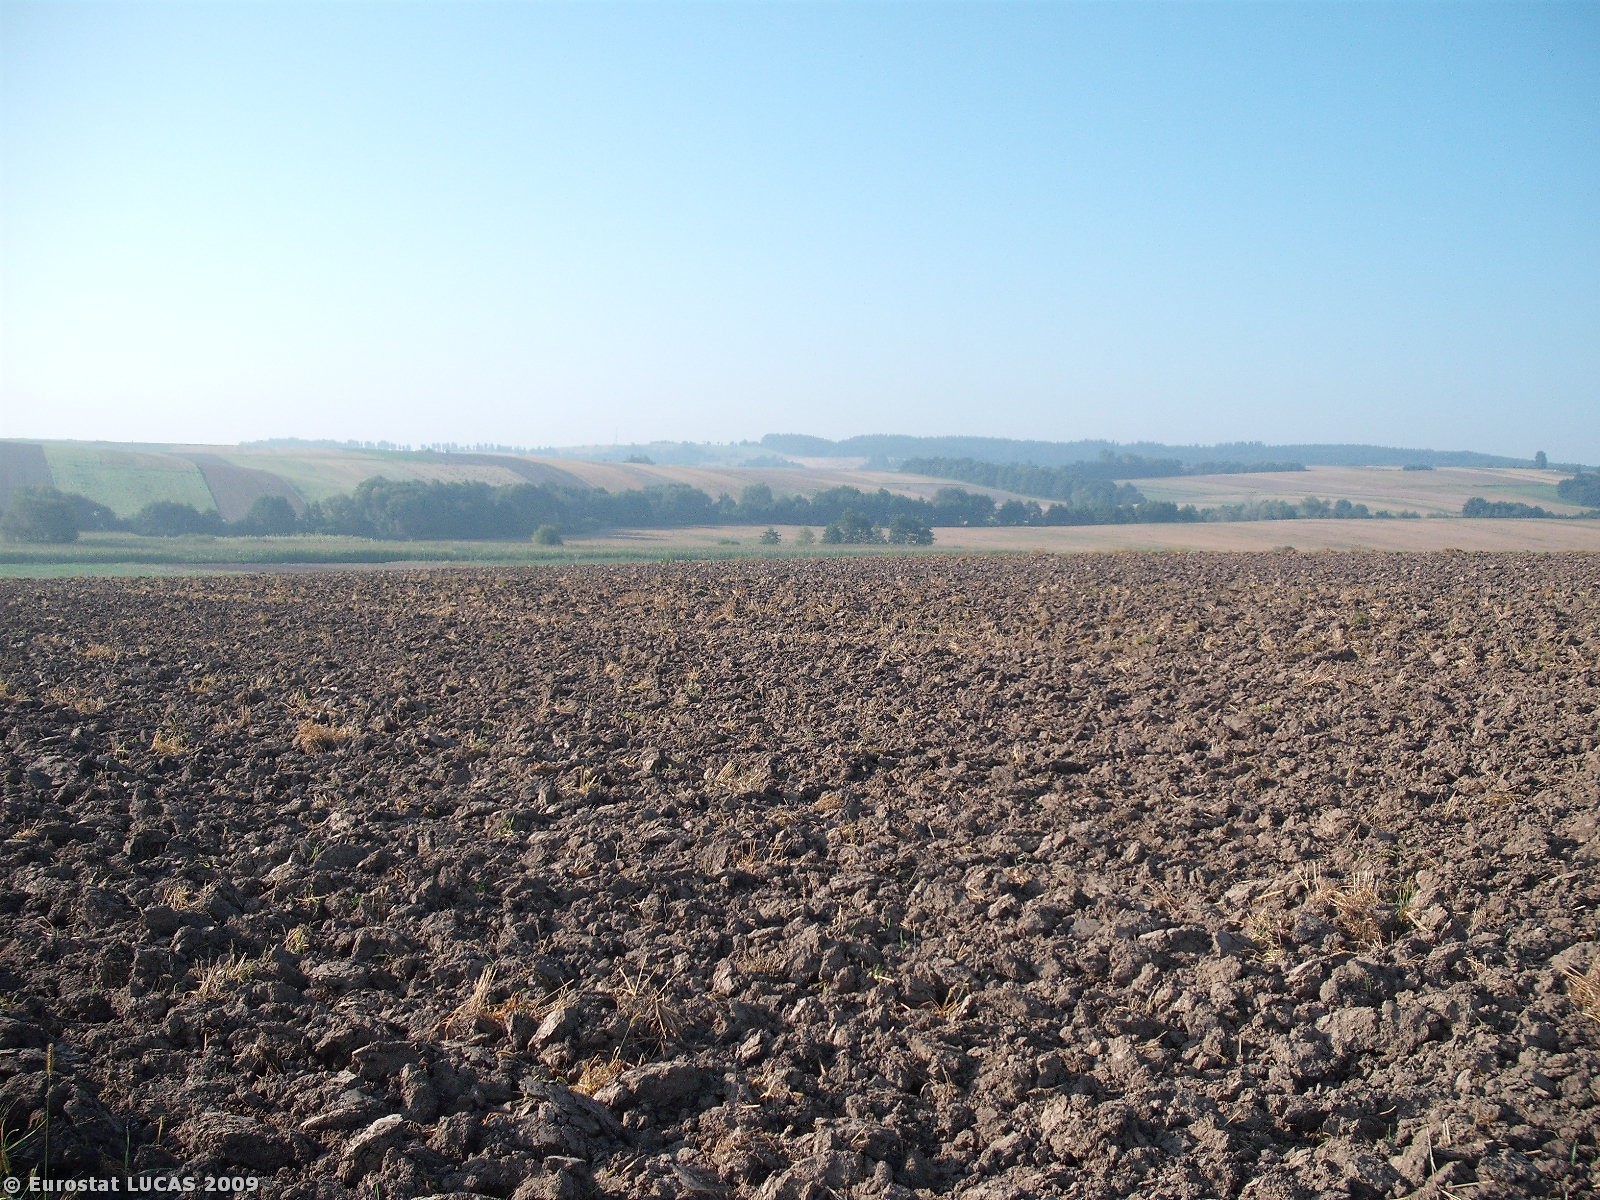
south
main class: Cropland
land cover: Rape and turnip rape
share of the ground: > 75 %
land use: Agriculture (excluding fallow land and kitchen gardens)
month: August
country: PL
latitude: 49.8724
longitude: 22.6883
